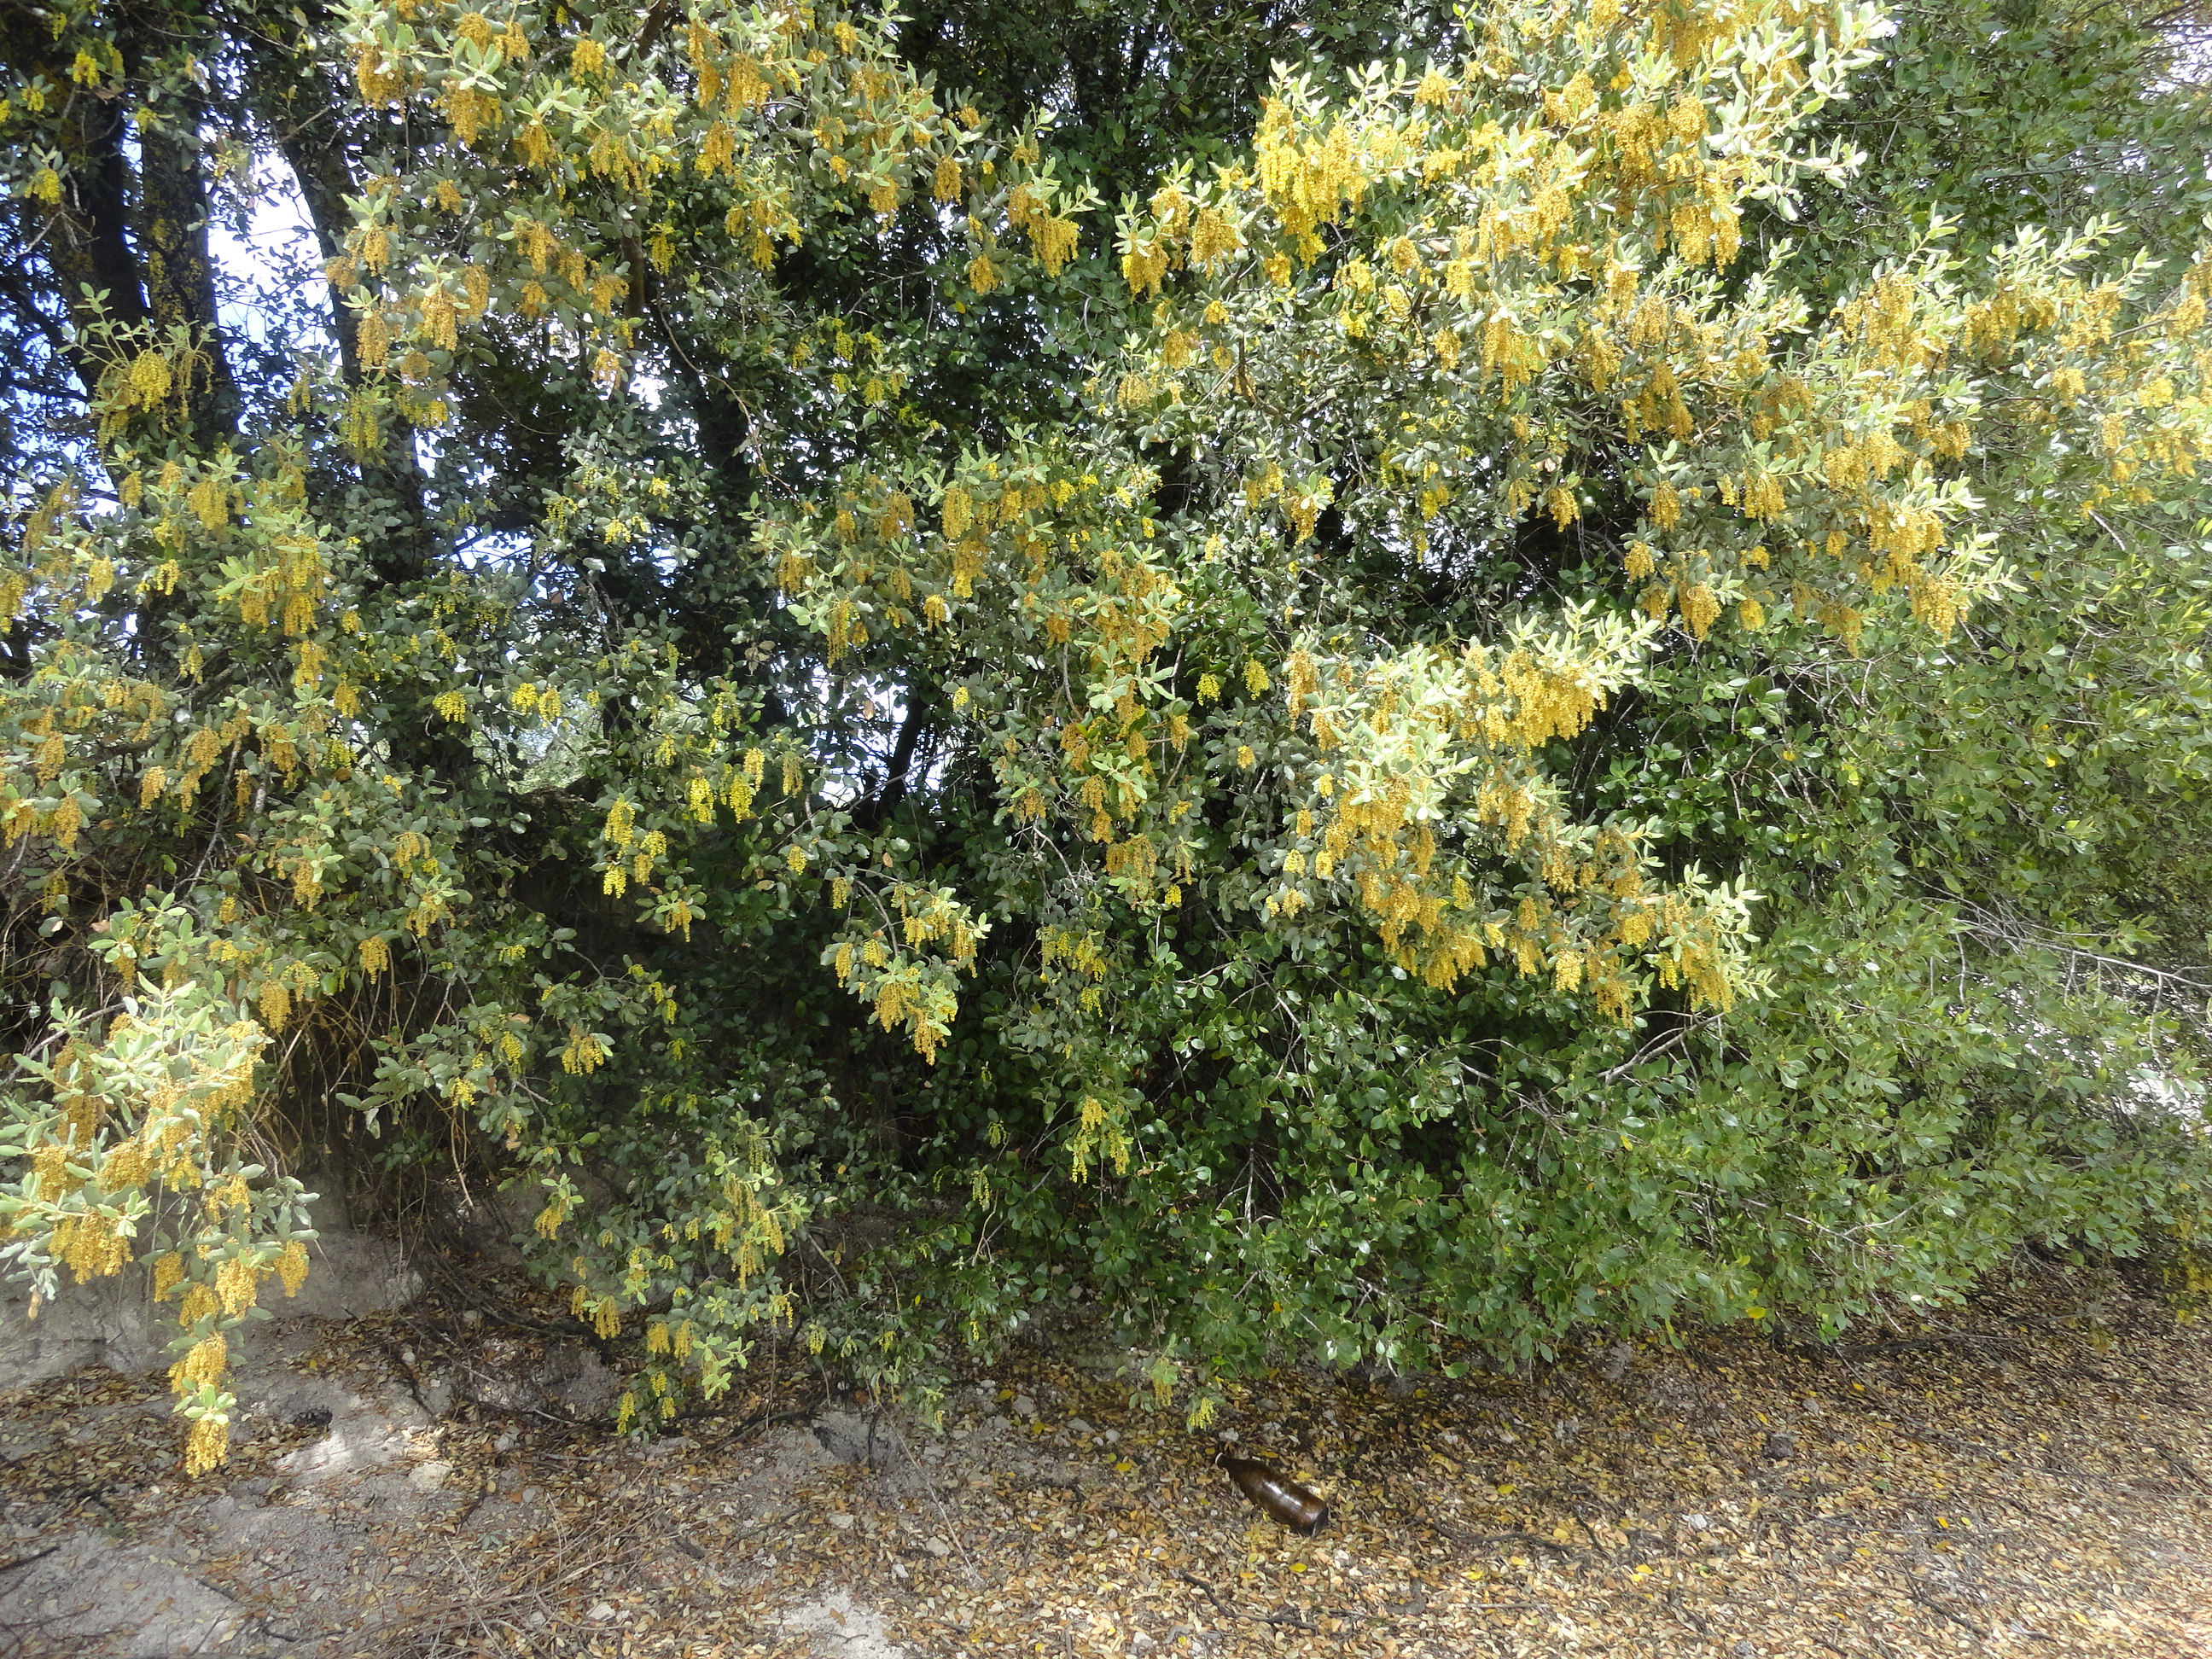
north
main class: Cropland
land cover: Olive groves
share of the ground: 50 - 75 %
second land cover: Spontaneously vegetated surfaces
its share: 10 - 25 %
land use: Agriculture (excluding fallow land and kitchen gardens)
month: April
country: ES
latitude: 37.6121
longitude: -4.4494
